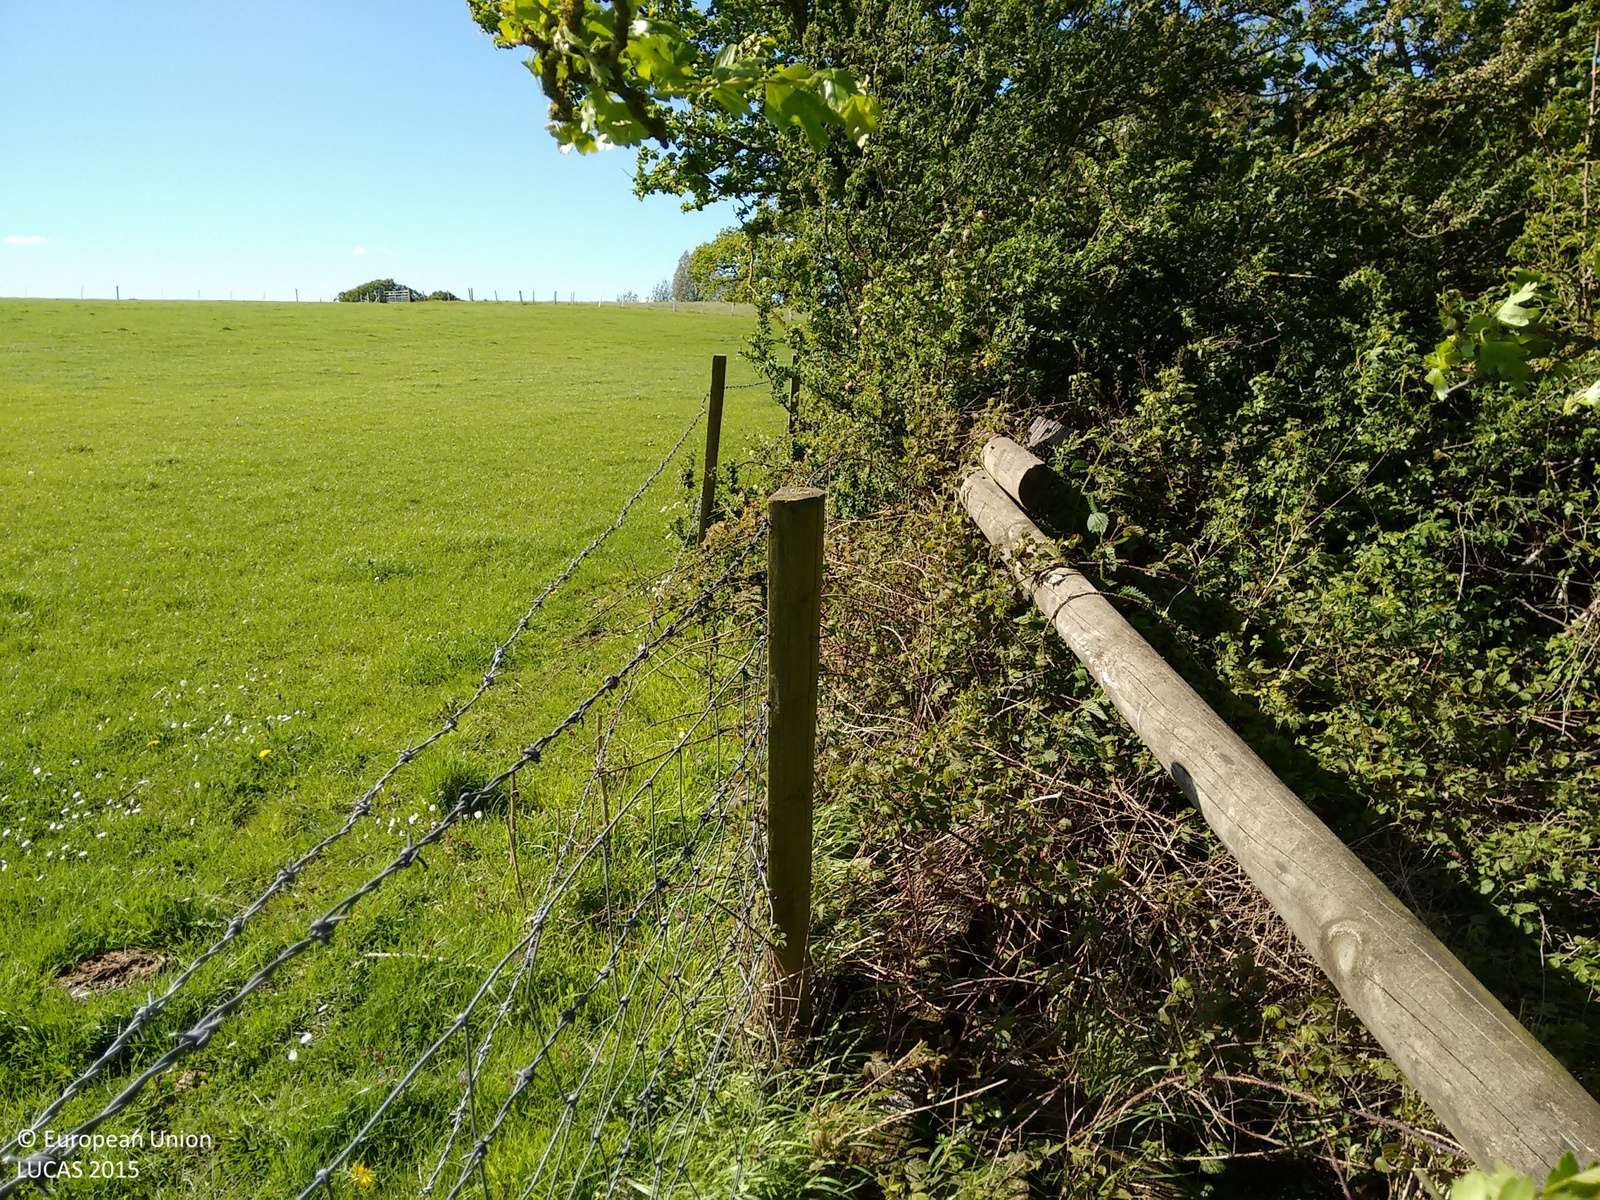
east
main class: Grassland
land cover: Grassland without tree/shrub cover
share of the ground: > 75 %
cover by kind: herbaceous plants 100 %
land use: Agriculture (excluding fallow land and kitchen gardens)
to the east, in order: Grassland without tree/shrub cover; Fences; Lines of trees; Paved roads, cycling and walking lanes; Grass margins; Broadleaved woodland; Grassland without tree/shrub cover
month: May
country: GB
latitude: 52.2510
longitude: -1.6991
